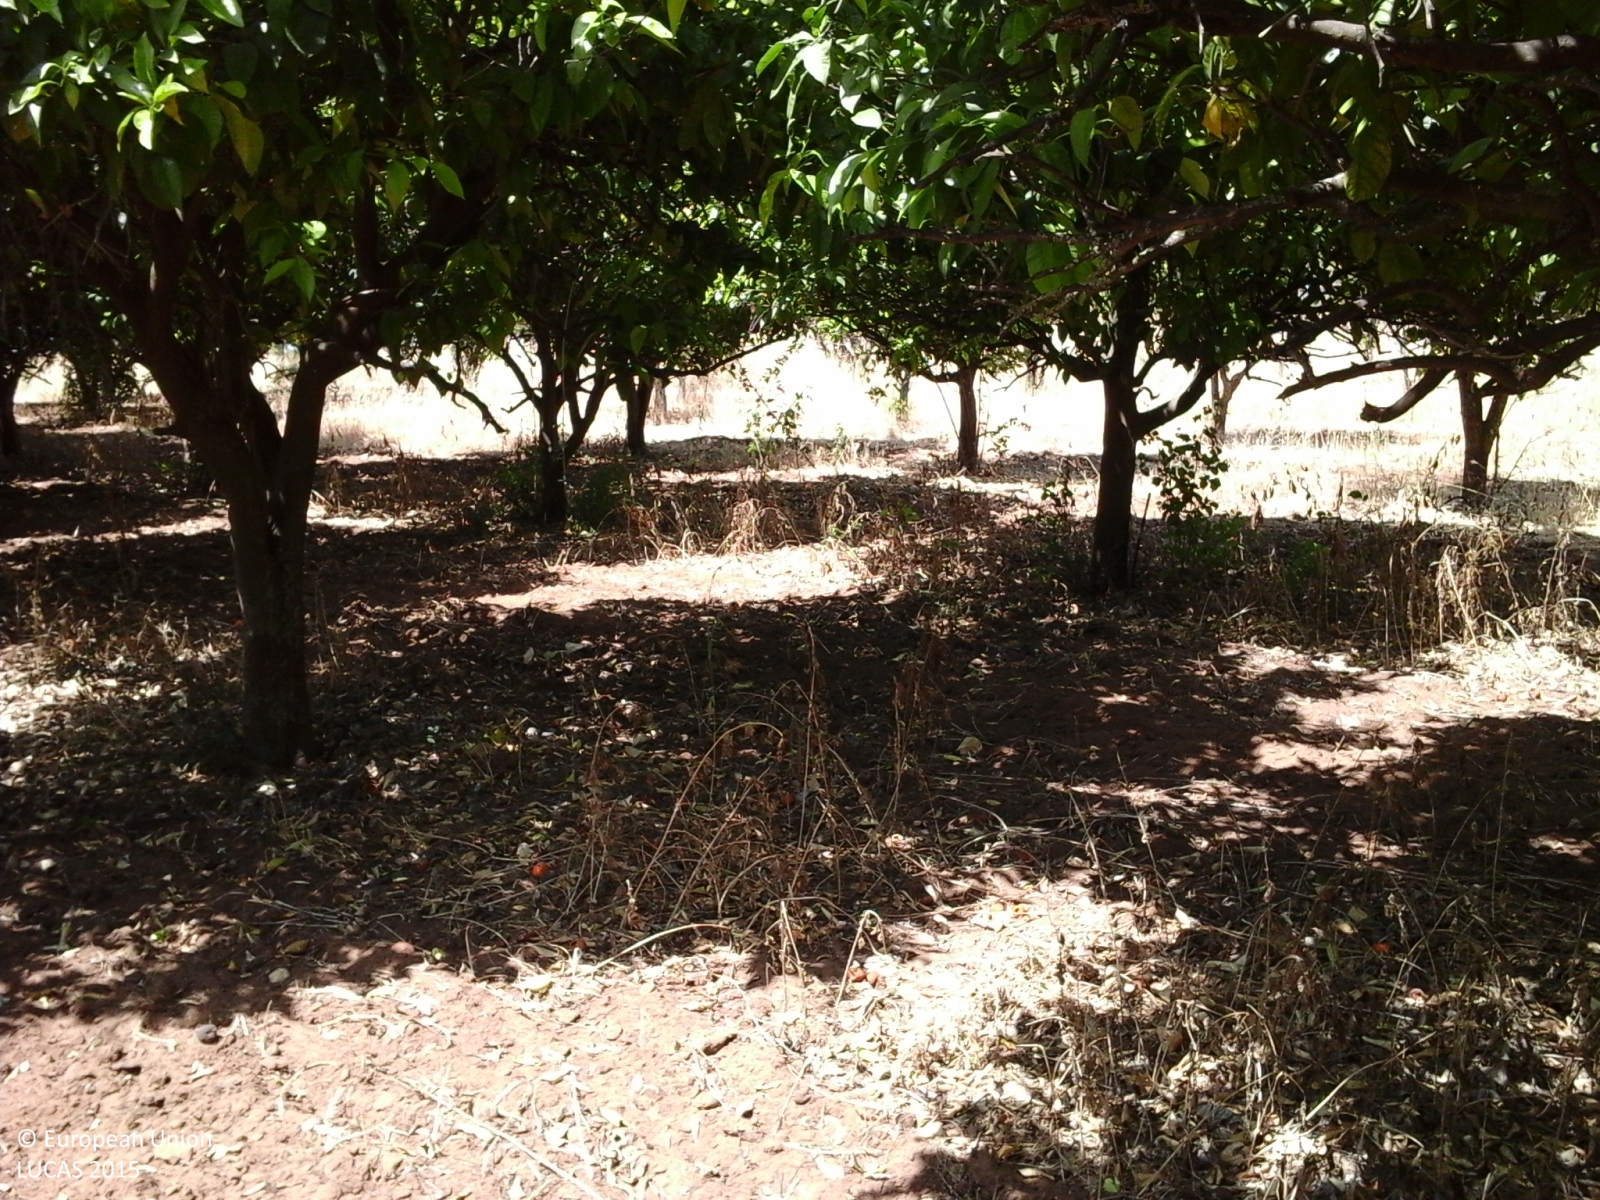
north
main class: Cropland
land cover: Other citrus fruit
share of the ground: > 75 %
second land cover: Spontaneously vegetated surfaces
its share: > 75 %
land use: Agriculture (excluding fallow land and kitchen gardens)
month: May
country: IT
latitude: 37.1467
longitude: 14.5695
